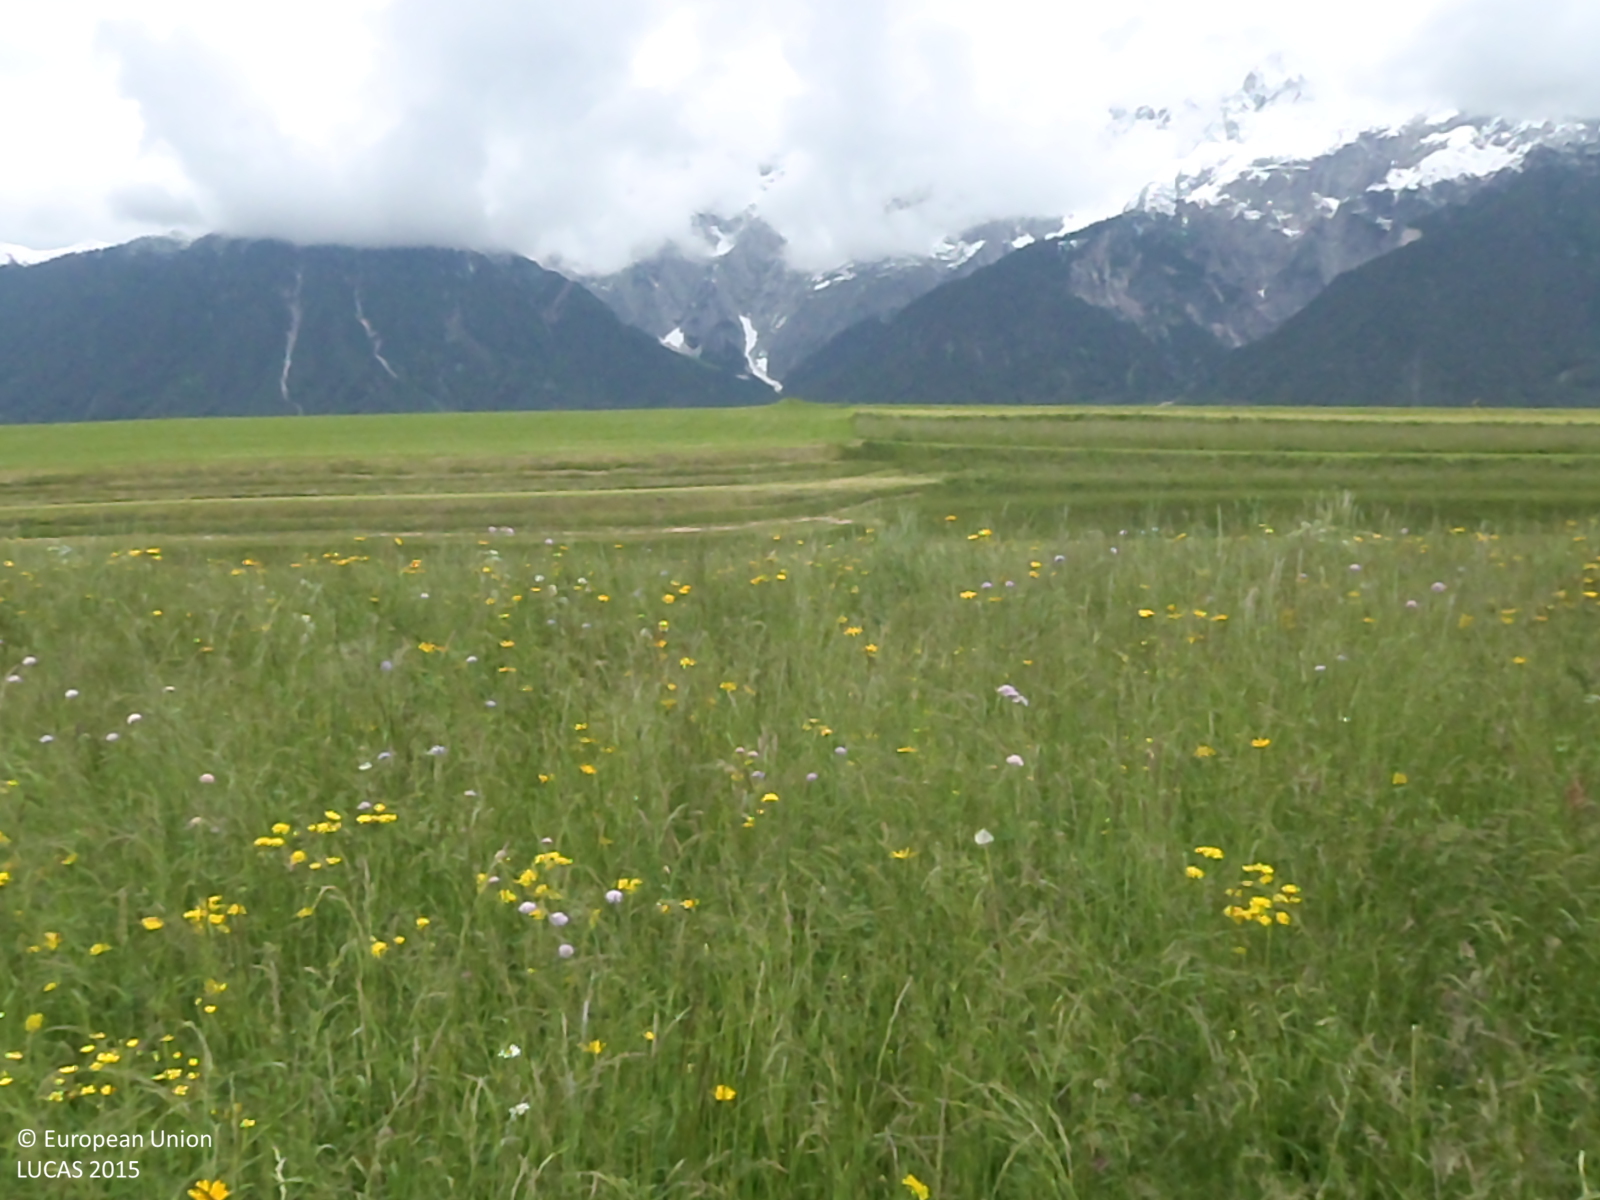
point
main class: Grassland
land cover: Grassland without tree/shrub cover
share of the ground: > 75 %
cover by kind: herbaceous plants 100 %
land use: Agriculture (excluding fallow land and kitchen gardens)
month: May
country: AT
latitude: 47.3011
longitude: 10.9910
